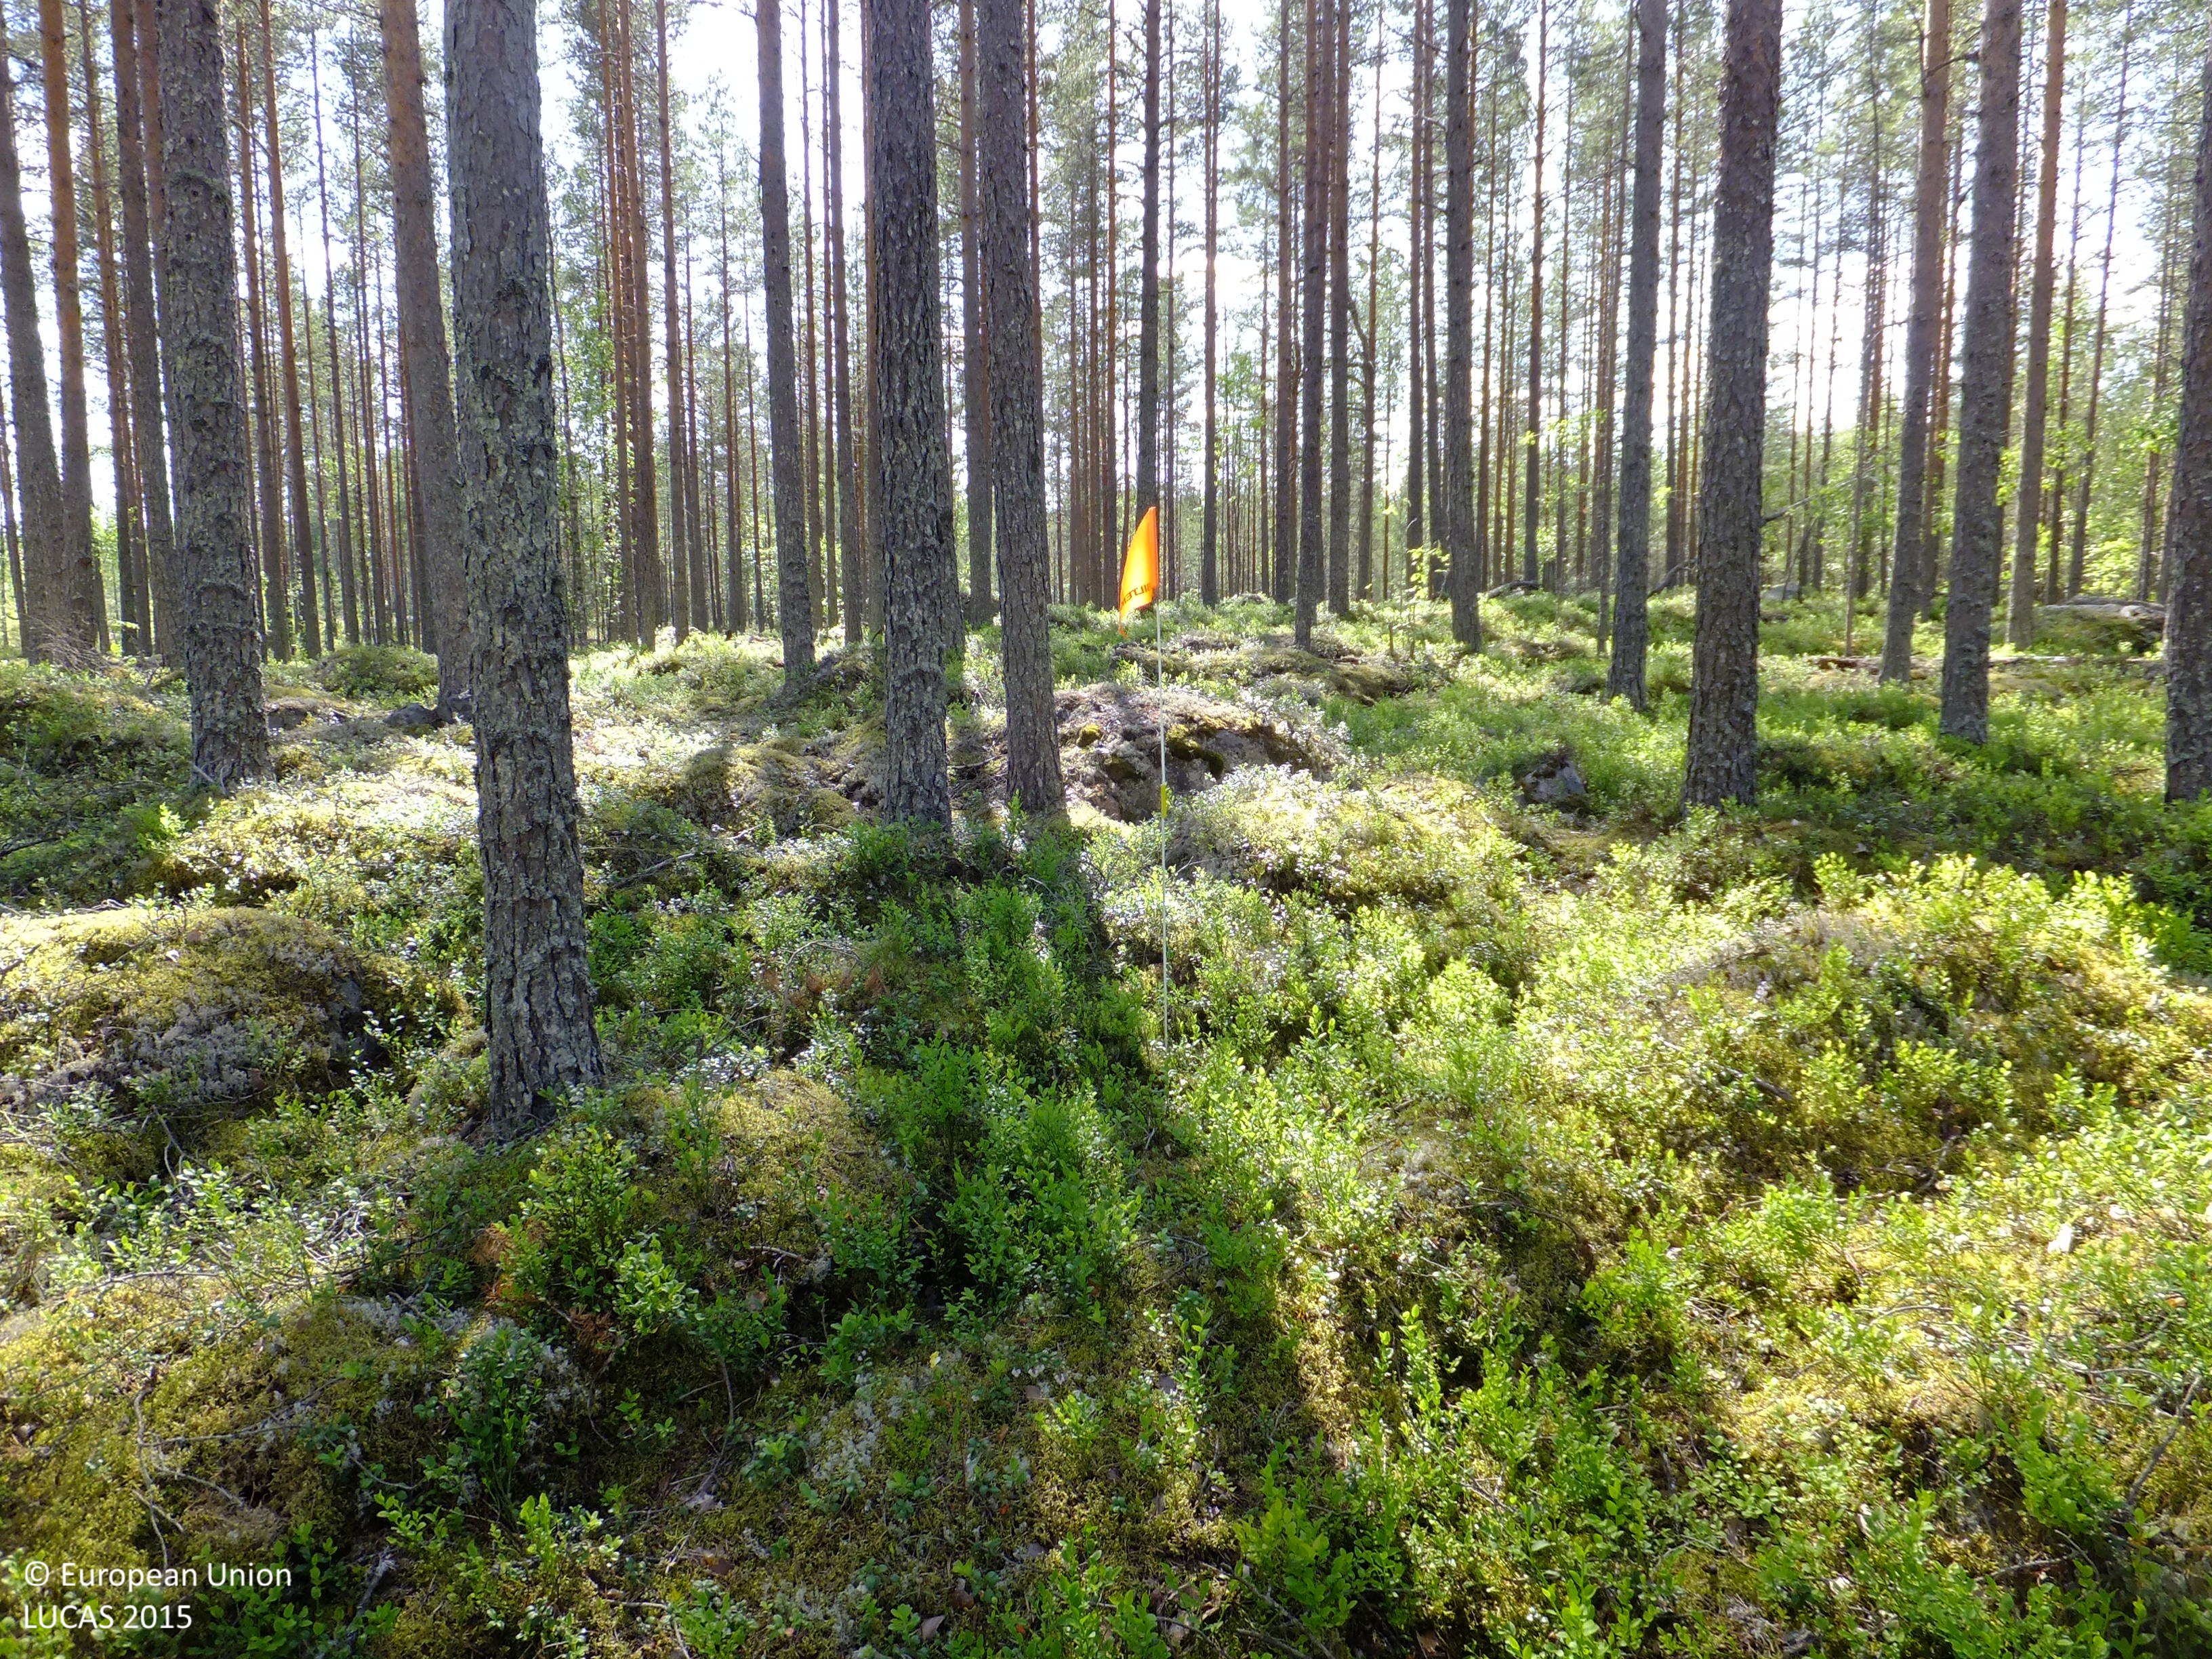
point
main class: Woodland
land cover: Pine dominated coniferous woodland
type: boreal forest
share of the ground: > 75 %
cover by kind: coniferous forest trees 80 %, broadleaved forest trees 5 %, shrubs 5 %, lichens and mosses 5 %, consolidated bare surface 5 %
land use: Forestry
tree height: > 5 m
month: July
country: FI
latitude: 63.3007
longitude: 24.9125
